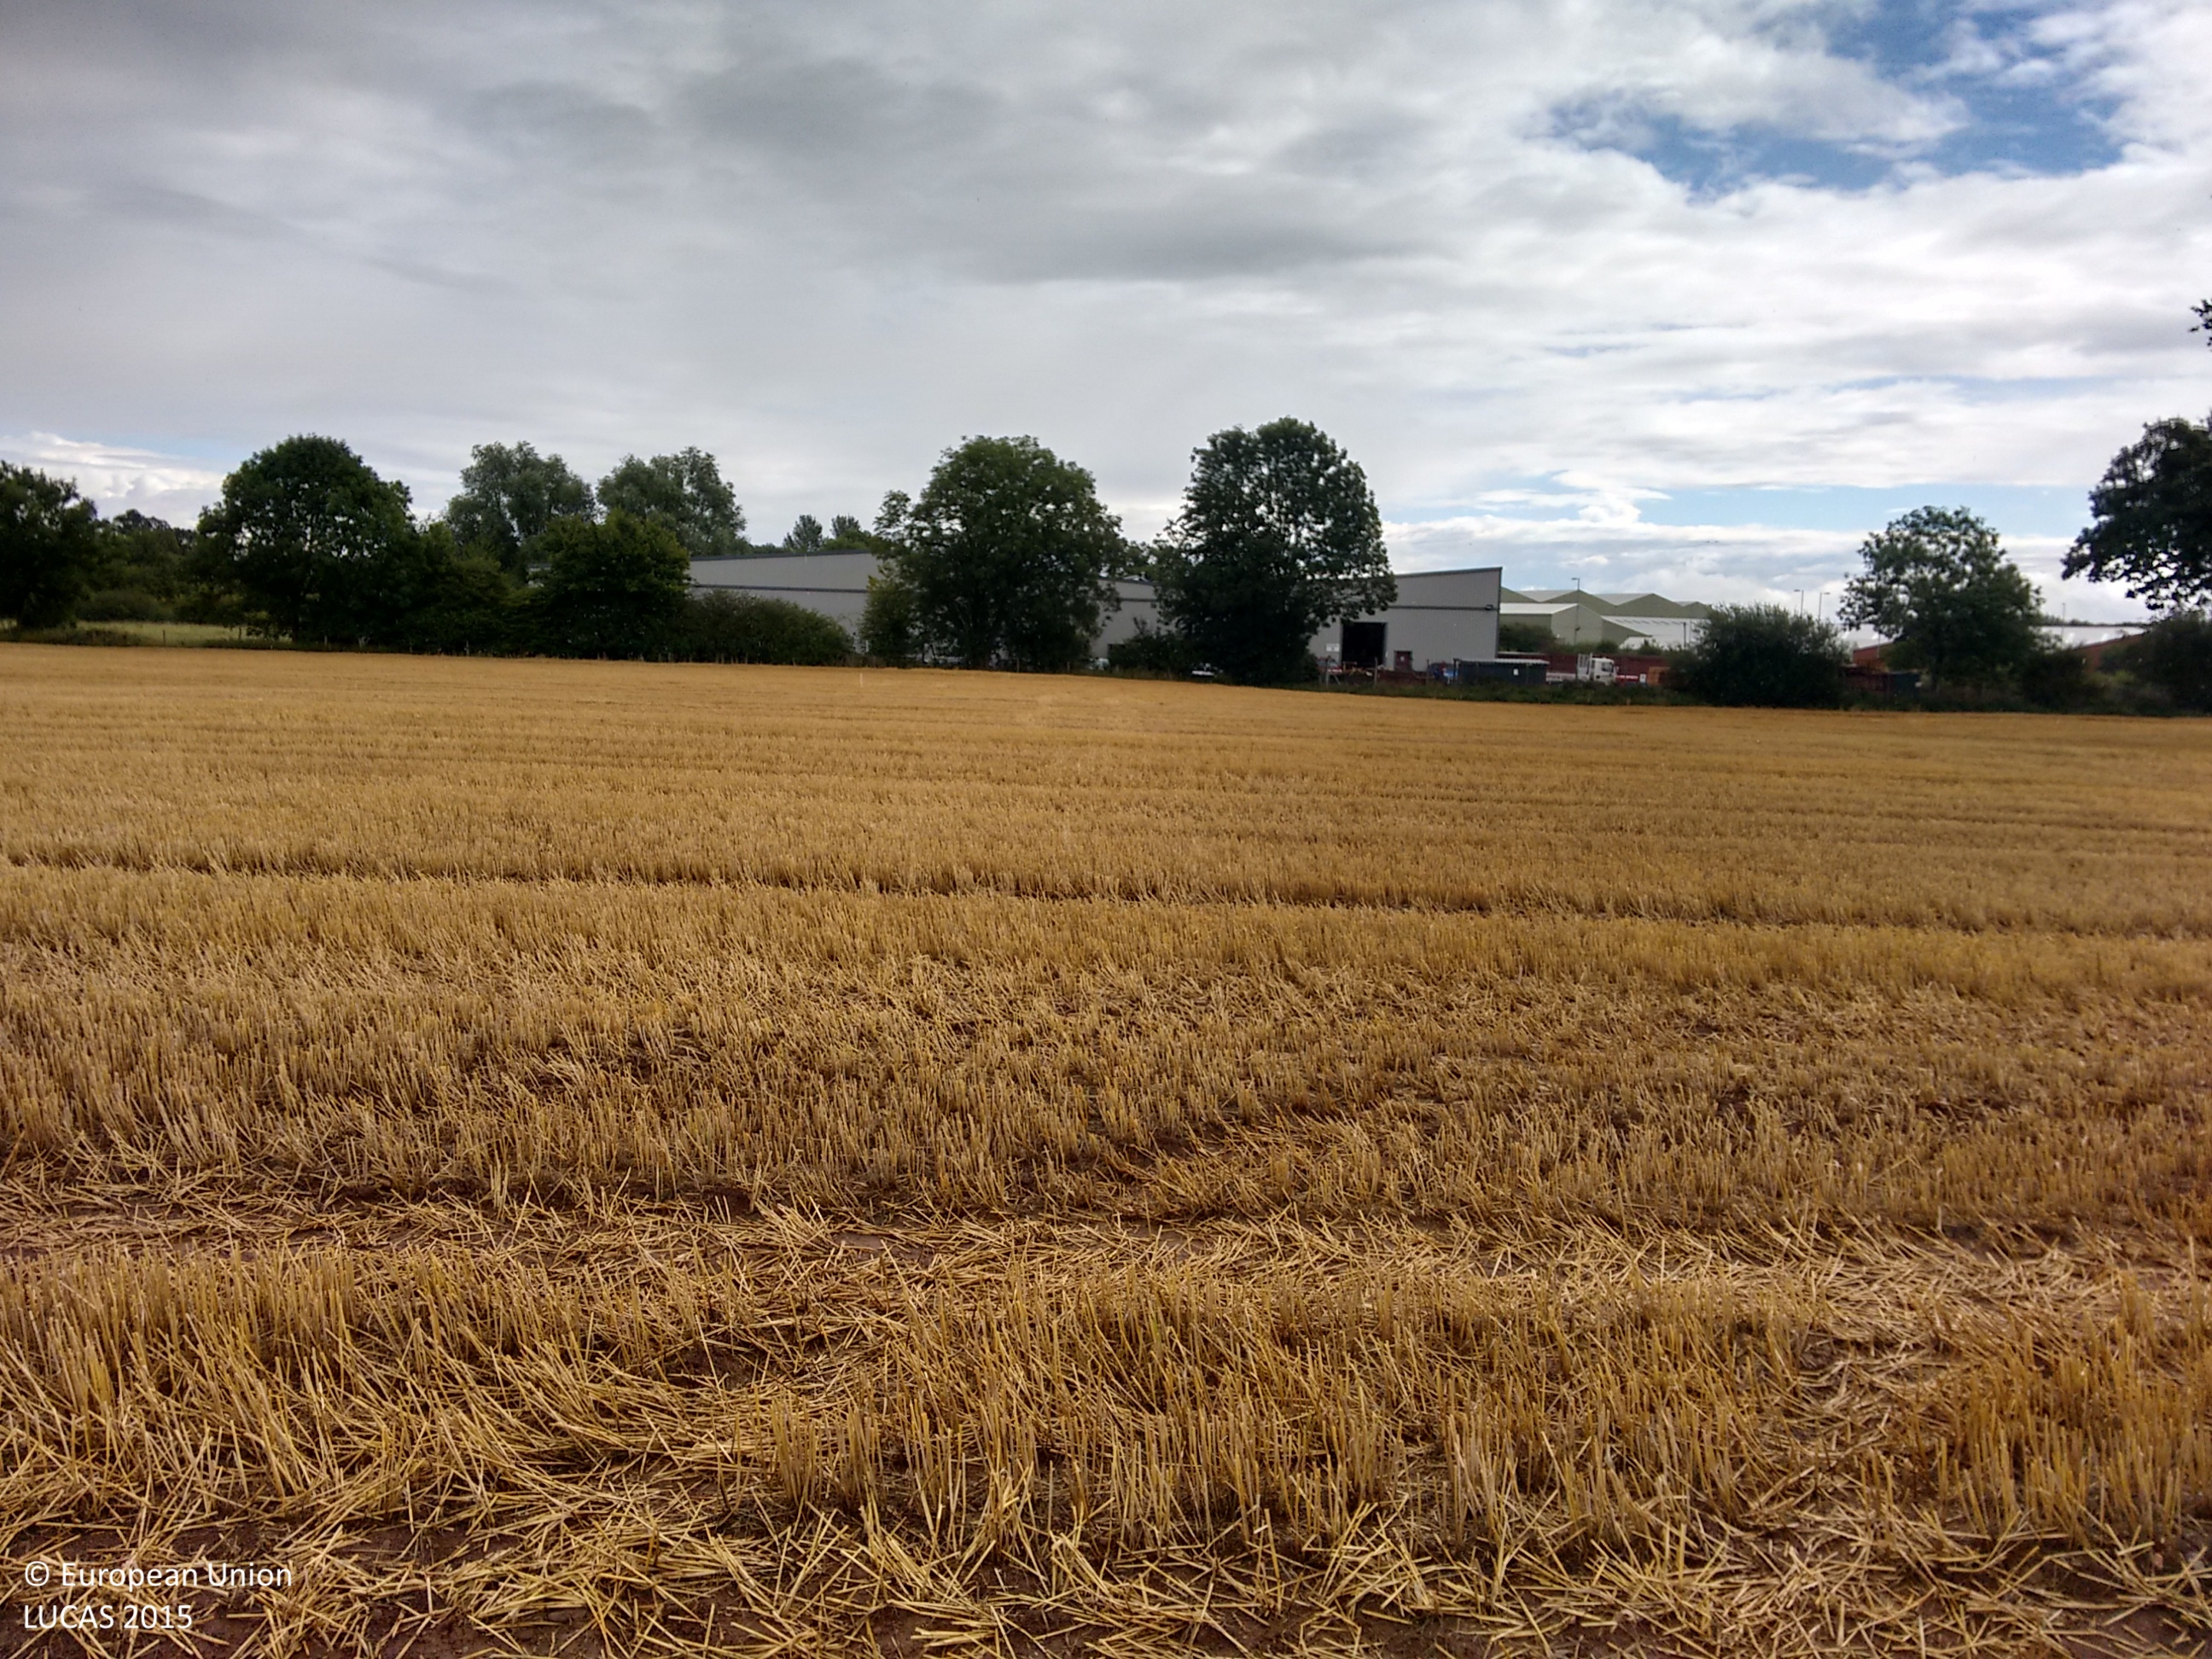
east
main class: Cropland
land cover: Barley
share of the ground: > 75 %
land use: Agriculture (excluding fallow land and kitchen gardens)
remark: Harvested field
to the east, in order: Barley; Single bushes/trees; Artificial constructions in urban areas; Rivers and streams; Grass margins; Paved roads, cycling and walking lanes; Grass margins; Fences; Other bare soil; Grass margins; Abandoned hedges; Ditches and canals; Broadleaved woodland
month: September
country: GB
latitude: 53.0316
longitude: -2.9422
